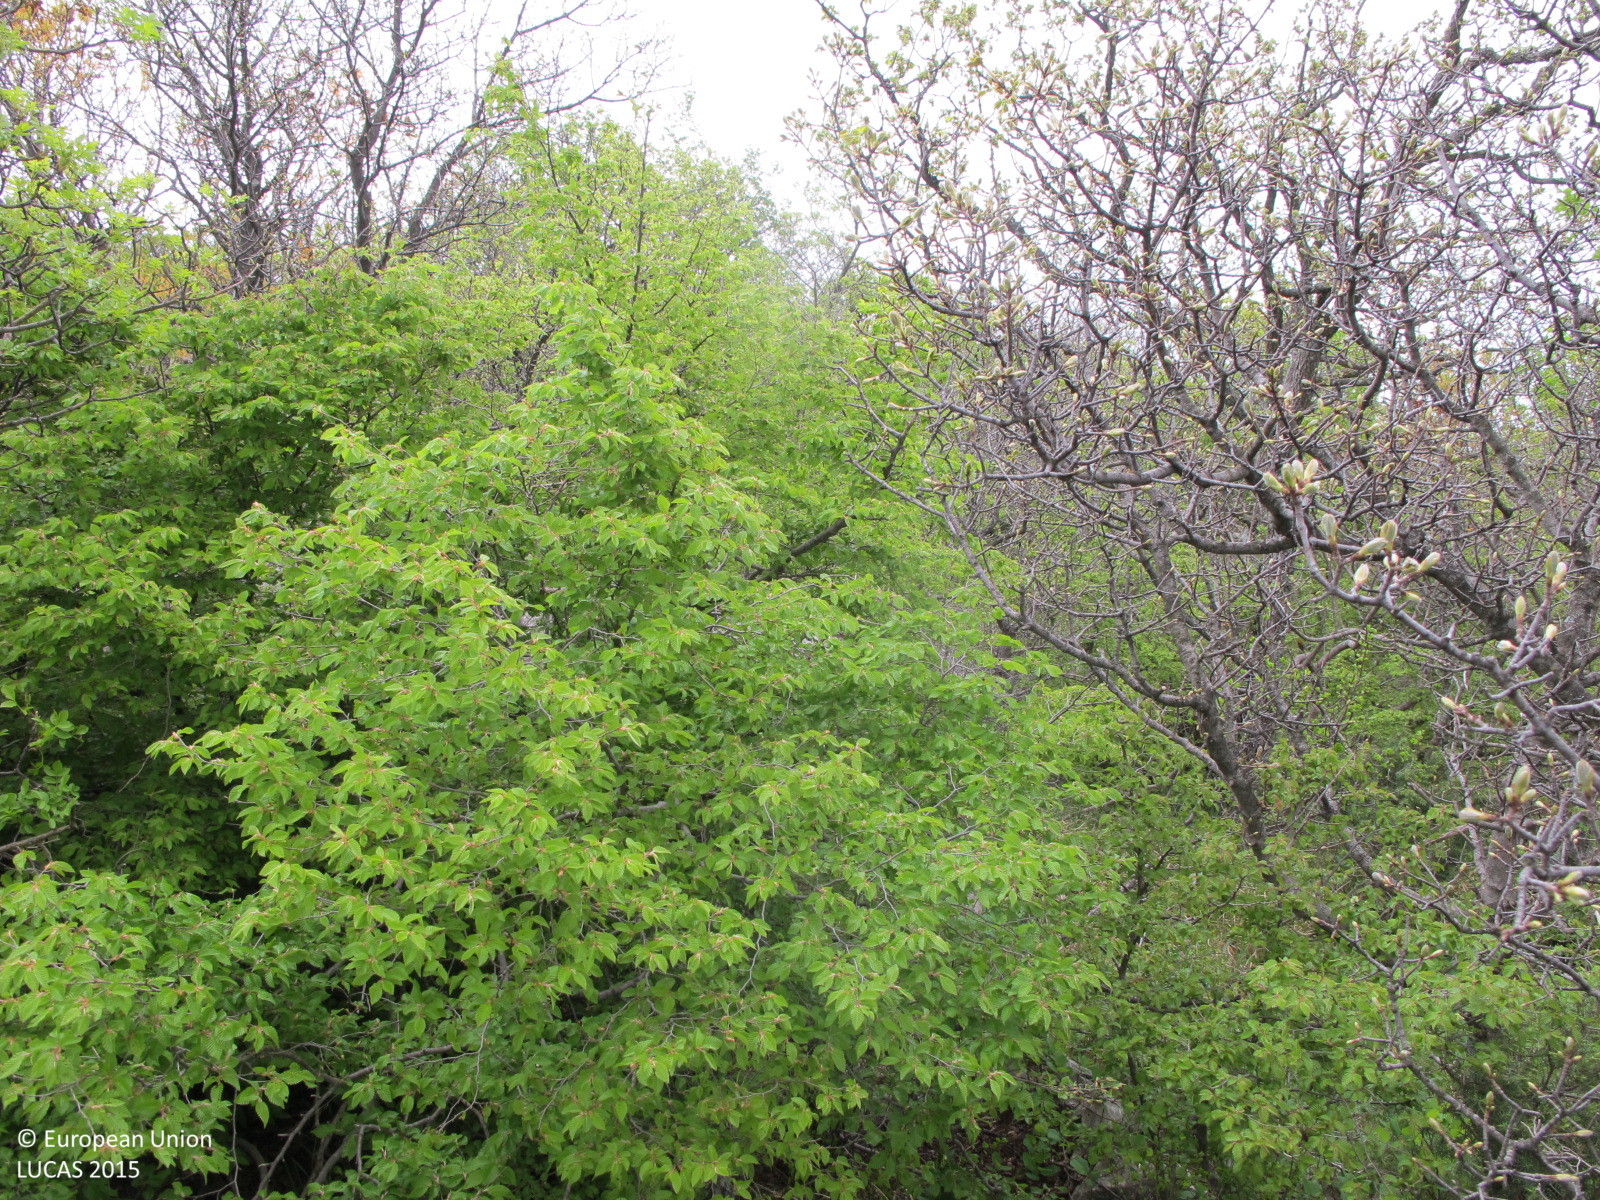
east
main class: Woodland
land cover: Broadleaved woodland
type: thermophilous deciduous forest
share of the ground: > 75 %
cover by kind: broadleaved forest trees 75 %, shrubs 20 %
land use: Semi-natural and natural areas not in use
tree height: < 5 m
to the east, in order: Broadleaved woodland; Shrubland without tree cover; Broadleaved woodland; Rocks and stones; Broadleaved woodland; Shrubland with sparse tree cover; Broadleaved woodland
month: April
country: HR
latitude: 45.2409
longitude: 14.6192
